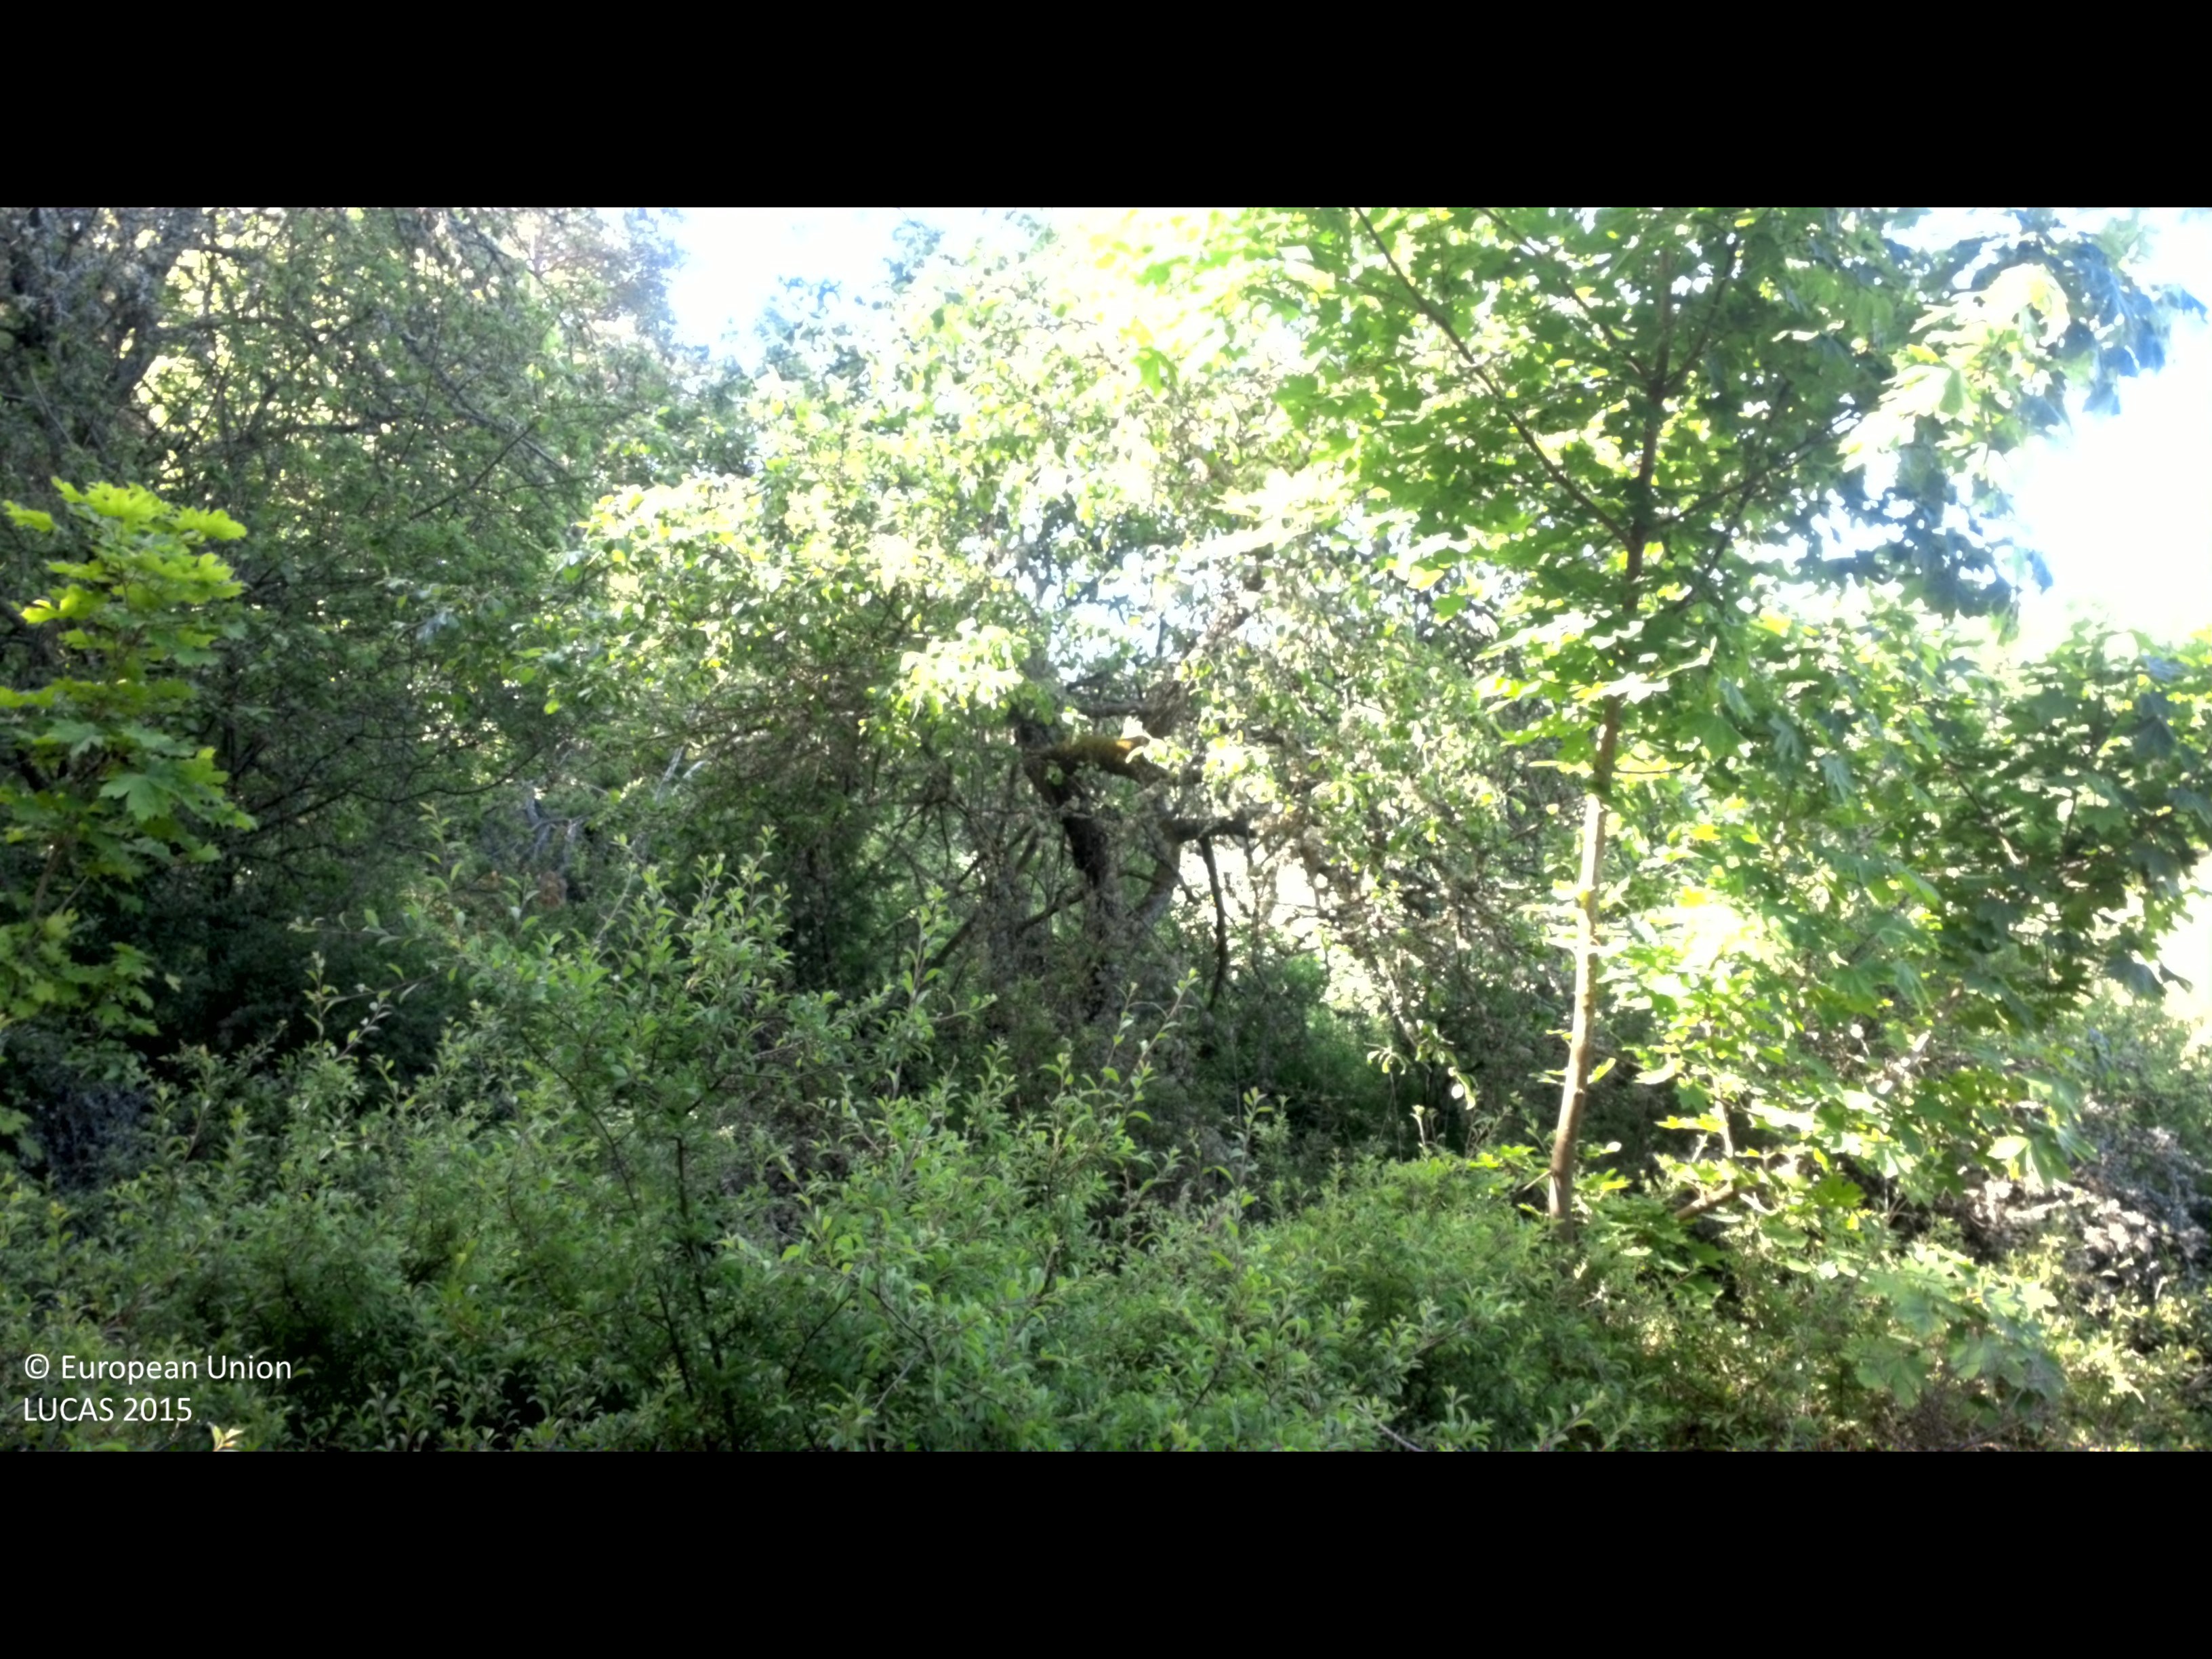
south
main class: Woodland
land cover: Broadleaved woodland
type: hemiboreal forest and nemoral coniferous forest and mixed broadleaved-coniferous forest
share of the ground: 25 - 50 %
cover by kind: shrubs 50 %, broadleaved forest trees 40 %, unconsolidated bare surface 10 %
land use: Forestry
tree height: > 5 m
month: June
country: SE
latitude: 57.6105
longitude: 16.5099
